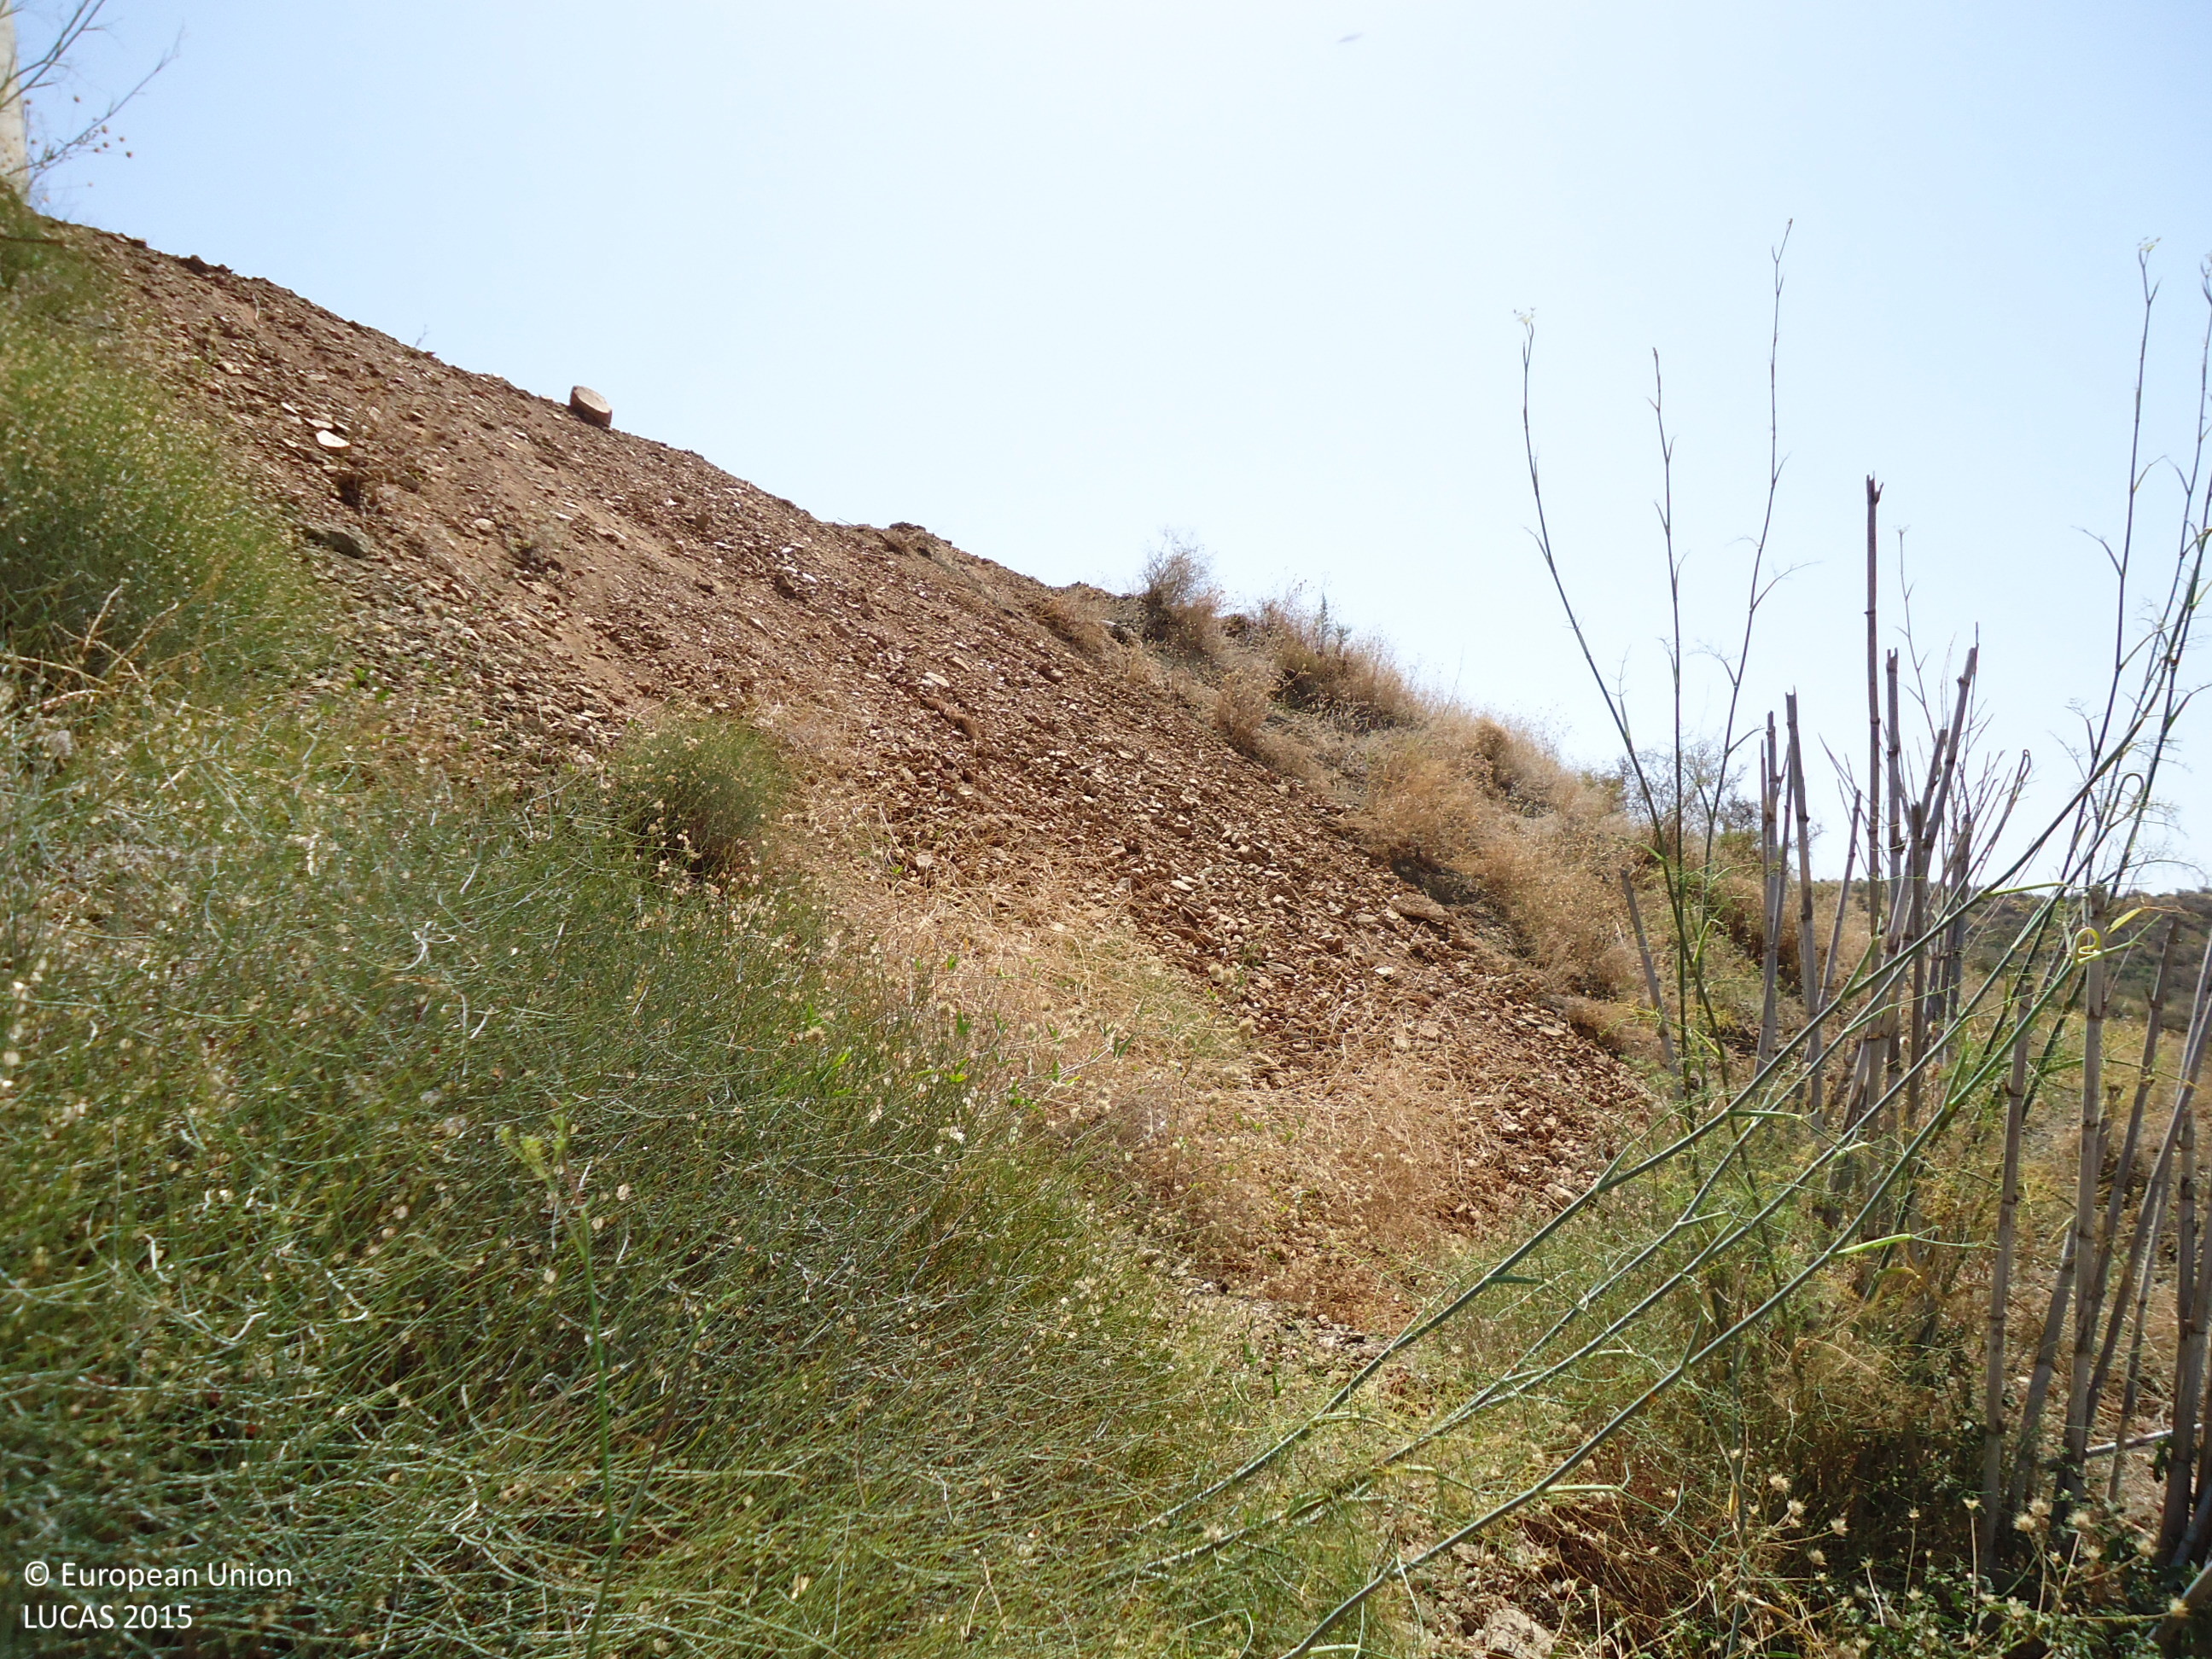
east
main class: Grassland
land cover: Grassland without tree/shrub cover
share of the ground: > 75 %
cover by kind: herbaceous plants 90 %, unconsolidated bare surface 10 %
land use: Semi-natural and natural areas not in use
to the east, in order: Grassland without tree/shrub cover; Other bare soil; Tracks; Fences; Grassland with sparse tree/shrub cover; Tracks; Fences; Other bare soil; Artificial constructions in urban areas; Other bare soil; Abandoned hedges; Fences; Paved roads, cycling and walking lanes; Fences; Permanent crops (only in case pi); Artificial constructions in urban areas
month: July
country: ES
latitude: 36.5251
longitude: -4.6976
